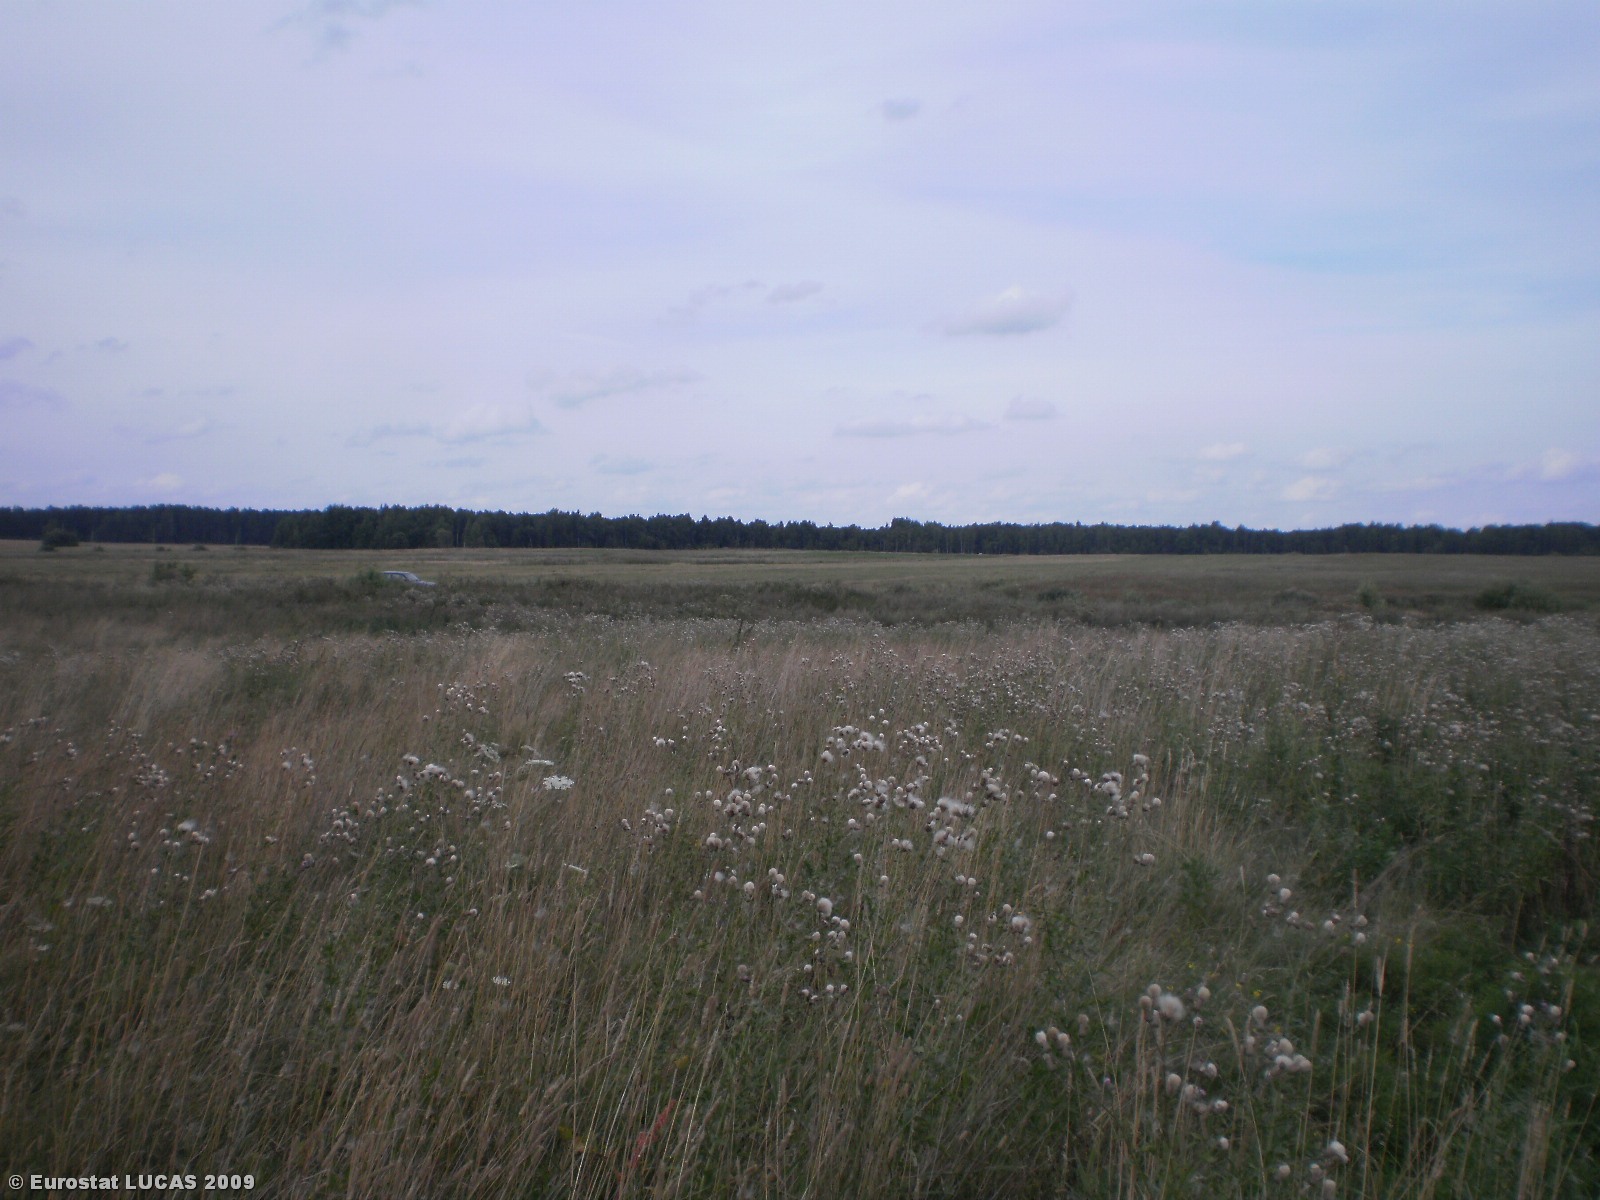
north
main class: Grassland
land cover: Grassland without tree/shrub cover
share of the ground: > 75 %
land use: Agriculture (excluding fallow land and kitchen gardens)
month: August
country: LT
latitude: 54.9954
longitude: 24.6260
